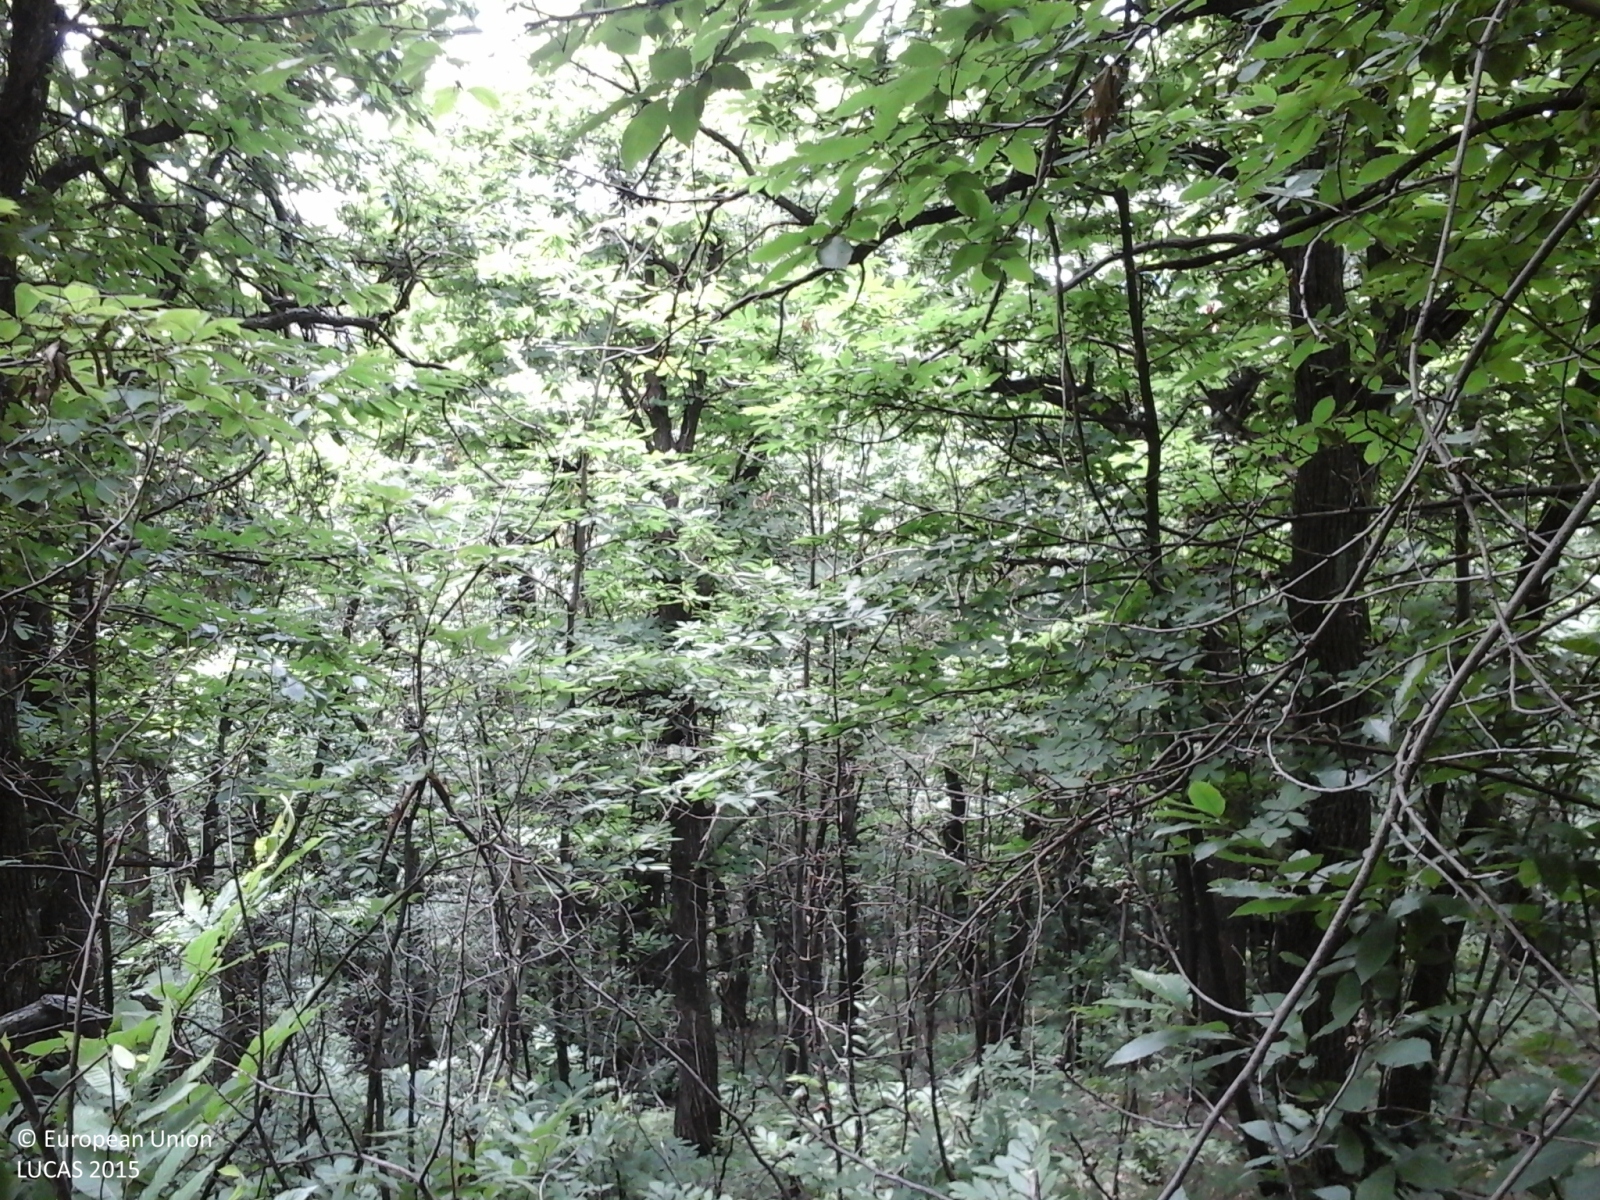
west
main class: Woodland
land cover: Broadleaved woodland
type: thermophilous deciduous forest
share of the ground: > 75 %
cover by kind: broadleaved forest trees 100 %
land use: Forestry
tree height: > 5 m
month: June
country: IT
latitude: 44.2914
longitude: 7.8116
